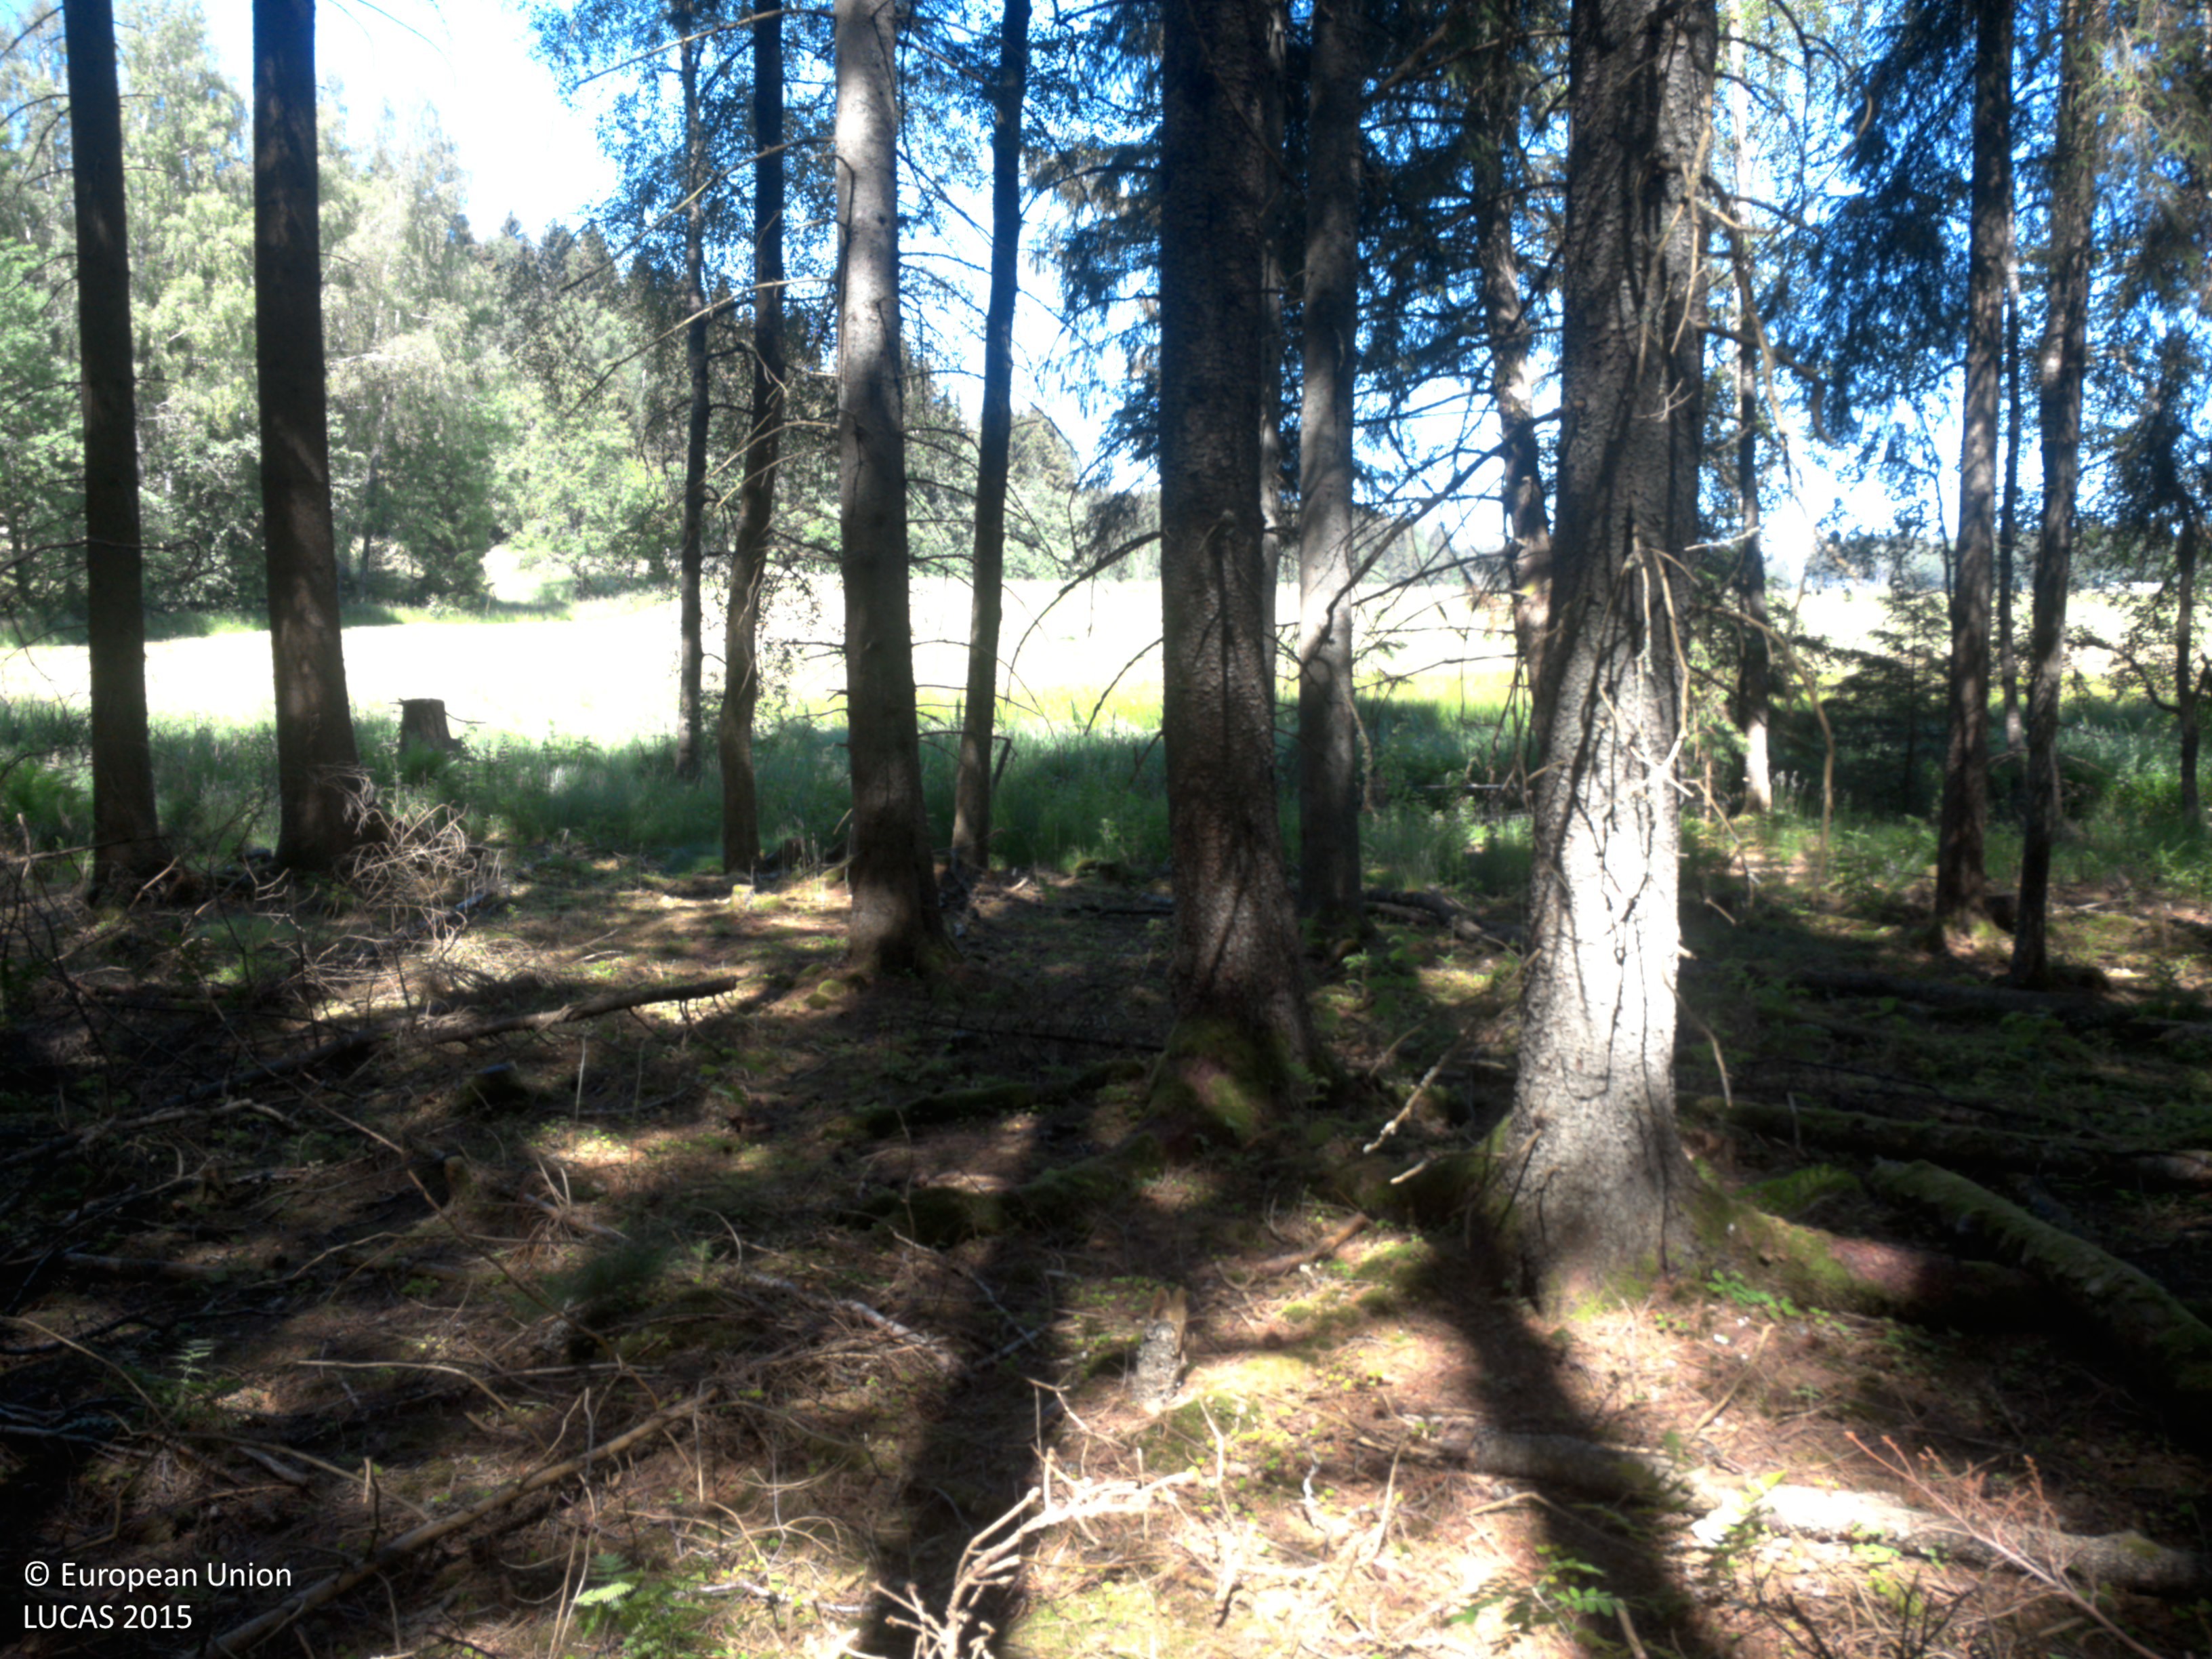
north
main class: Woodland
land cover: Spruce dominated coniferous woodland
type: boreal forest
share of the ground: > 75 %
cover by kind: coniferous forest trees 75 %, lichens and mosses 25 %
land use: Forestry
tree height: > 5 m
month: July
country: SE
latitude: 58.5114
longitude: 11.9356
